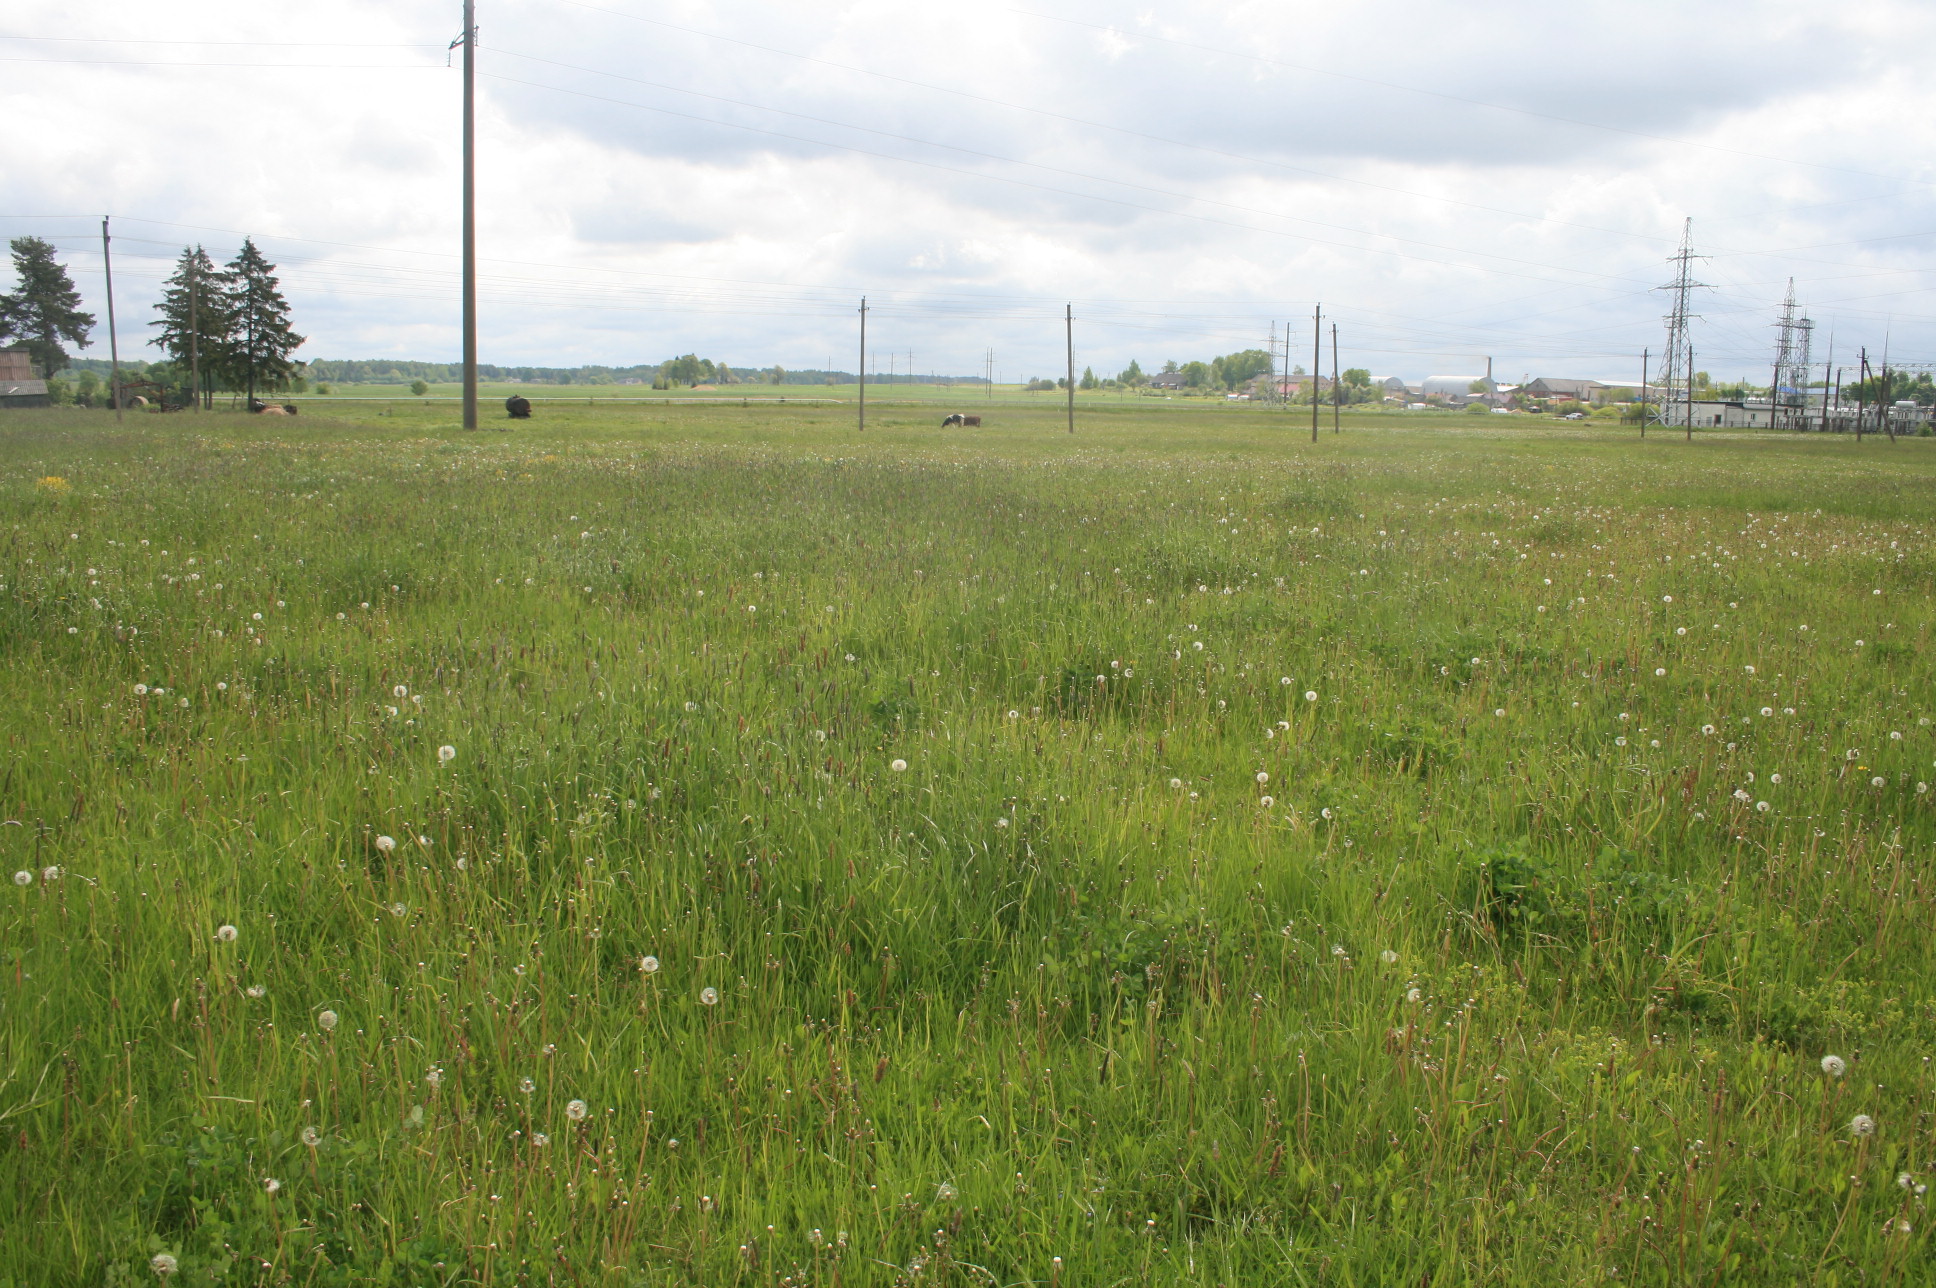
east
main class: Grassland
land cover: Grassland without tree/shrub cover
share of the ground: > 75 %
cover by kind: herbaceous plants 100 %
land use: Agriculture (excluding fallow land and kitchen gardens)
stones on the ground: < 10 %
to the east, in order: Grassland without tree/shrub cover; Electric lines; Grassland without tree/shrub cover; Electric lines; Grassland without tree/shrub cover; Electric lines; Grassland without tree/shrub cover; Electric lines; Grassland without tree/shrub cover; Lines of trees; Grassland without tree/shrub cover; Ditches and canals; Grass margins; Paved roads, cycling and walking lanes; Grass margins; Ditches and canals; Grassland without tree/shrub cover
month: May
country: LT
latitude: 55.7392
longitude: 21.9170
